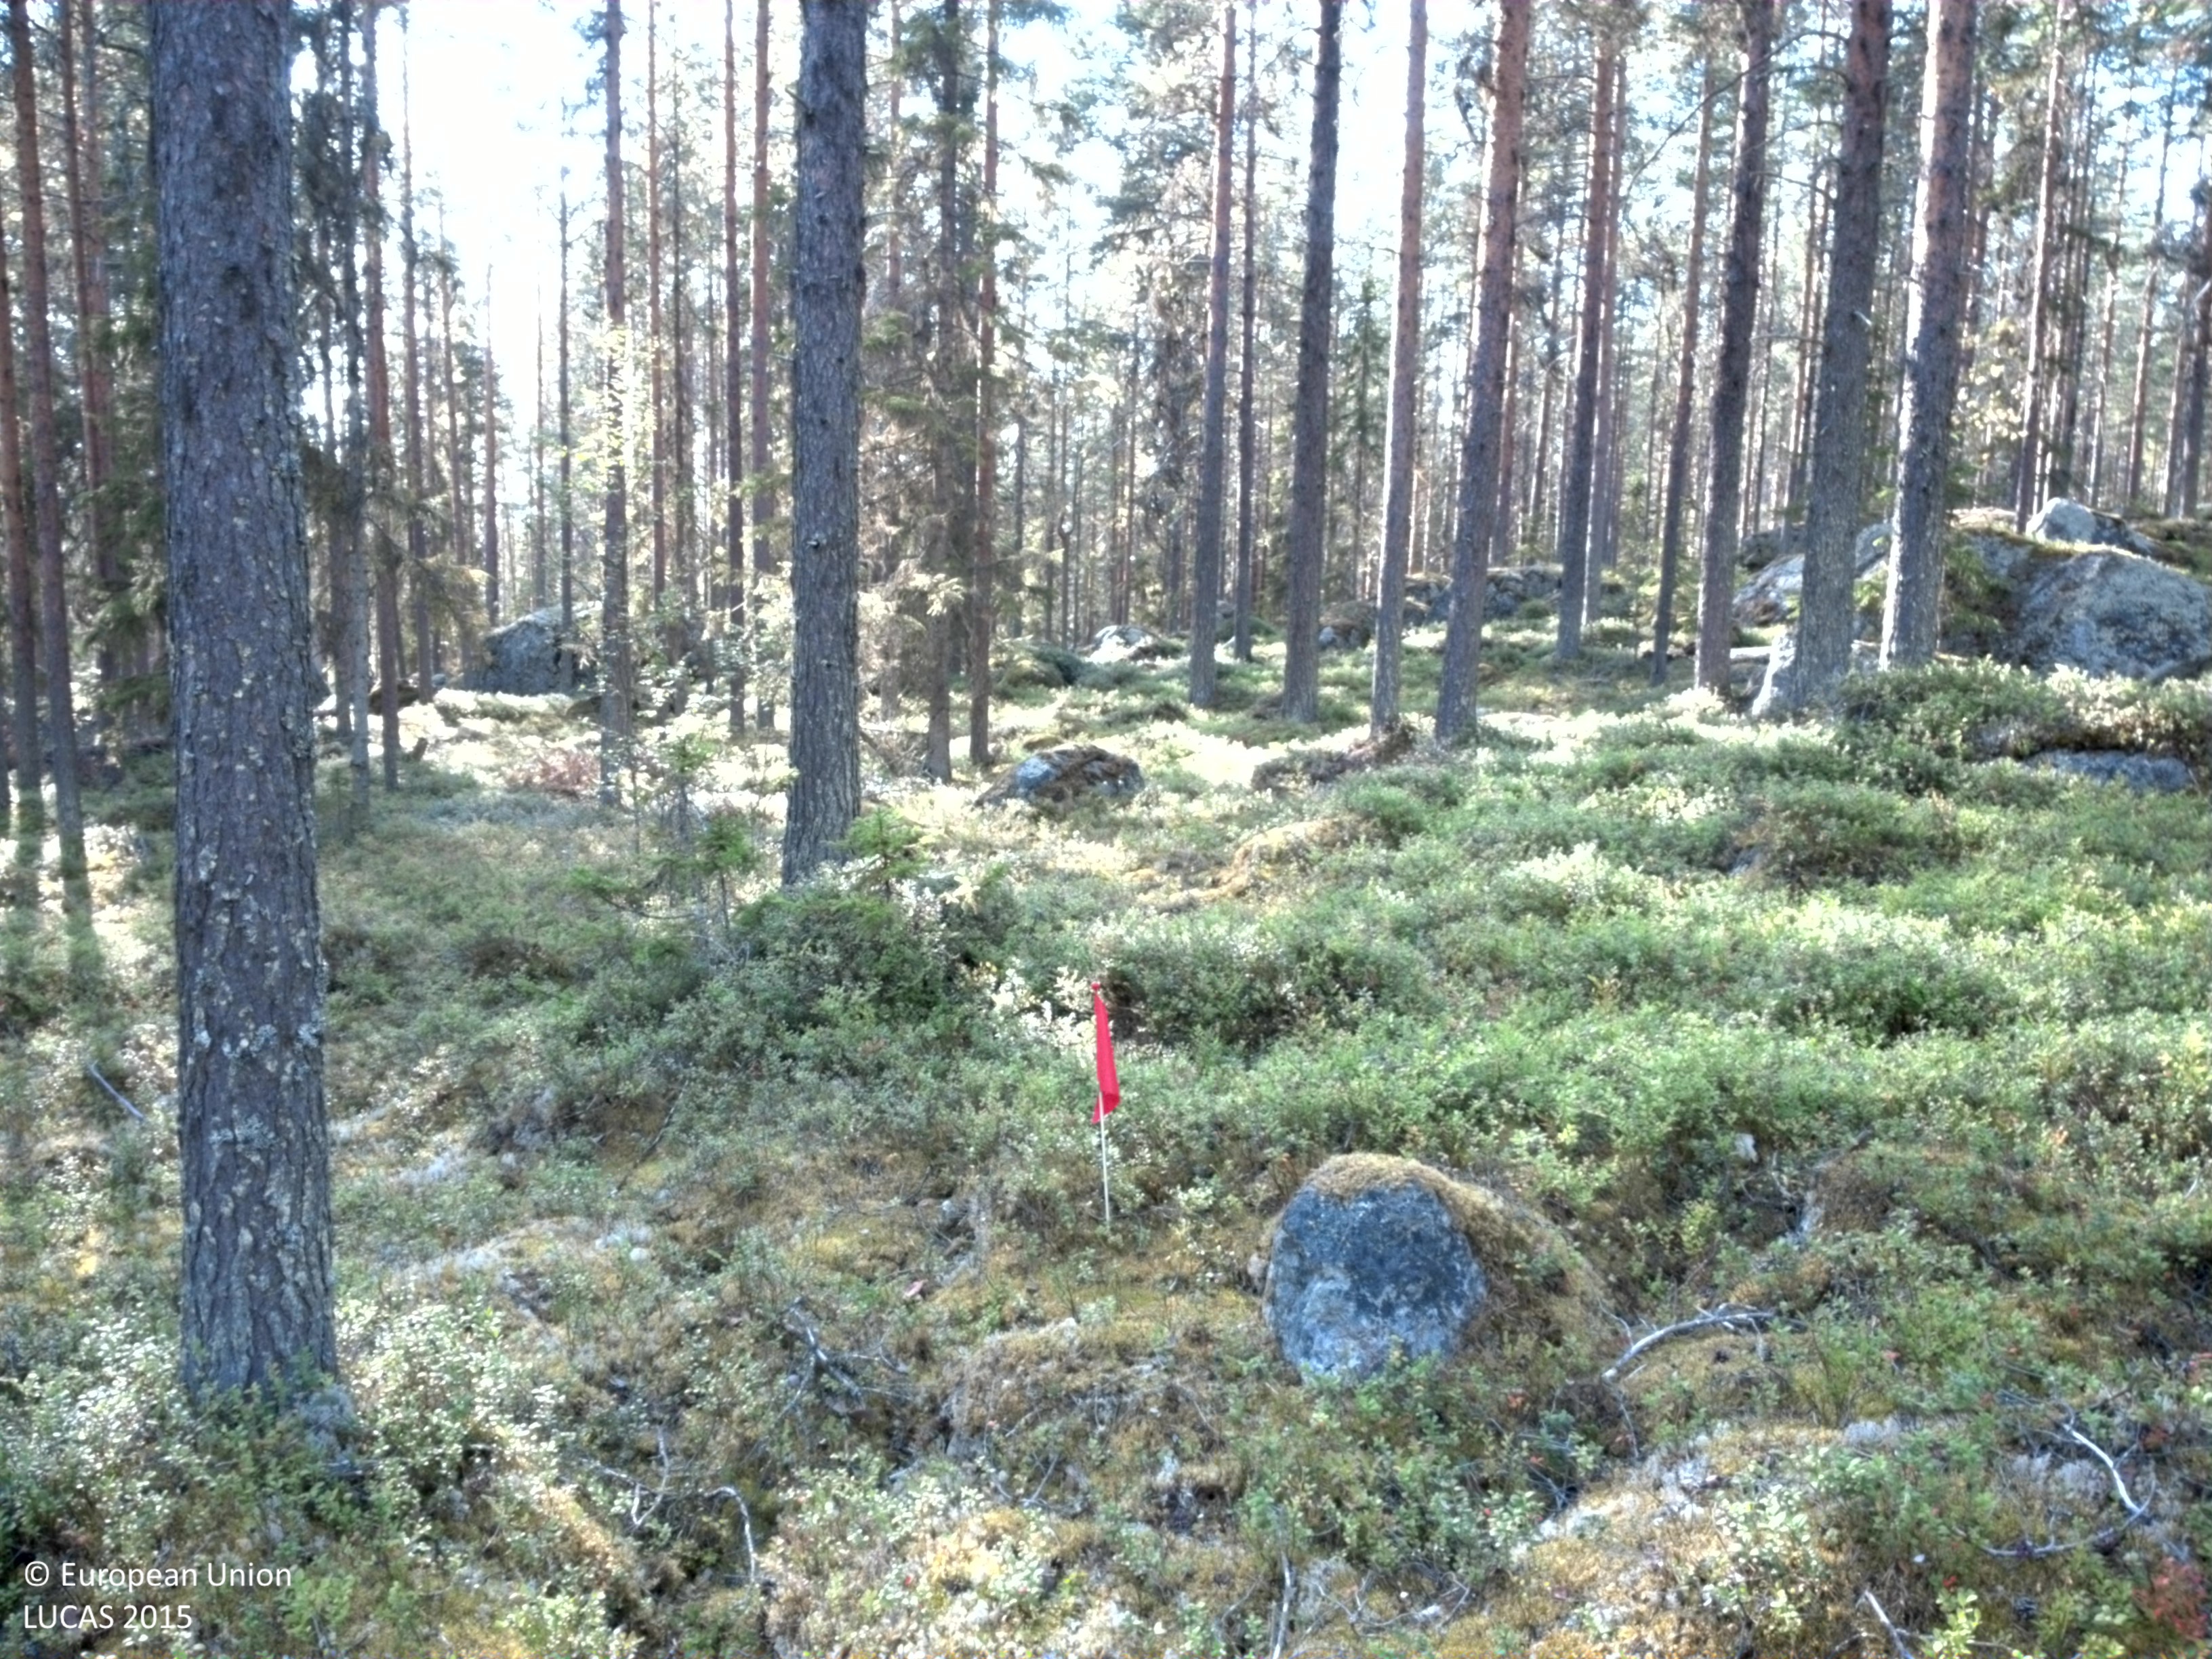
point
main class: Woodland
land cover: Pine dominated coniferous woodland
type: boreal forest
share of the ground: 50 - 75 %
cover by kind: coniferous forest trees 50 %, shrubs 45 %, lichens and mosses 5 %
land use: Forestry
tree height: > 5 m
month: August
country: SE
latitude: 64.4782
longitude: 18.8518
